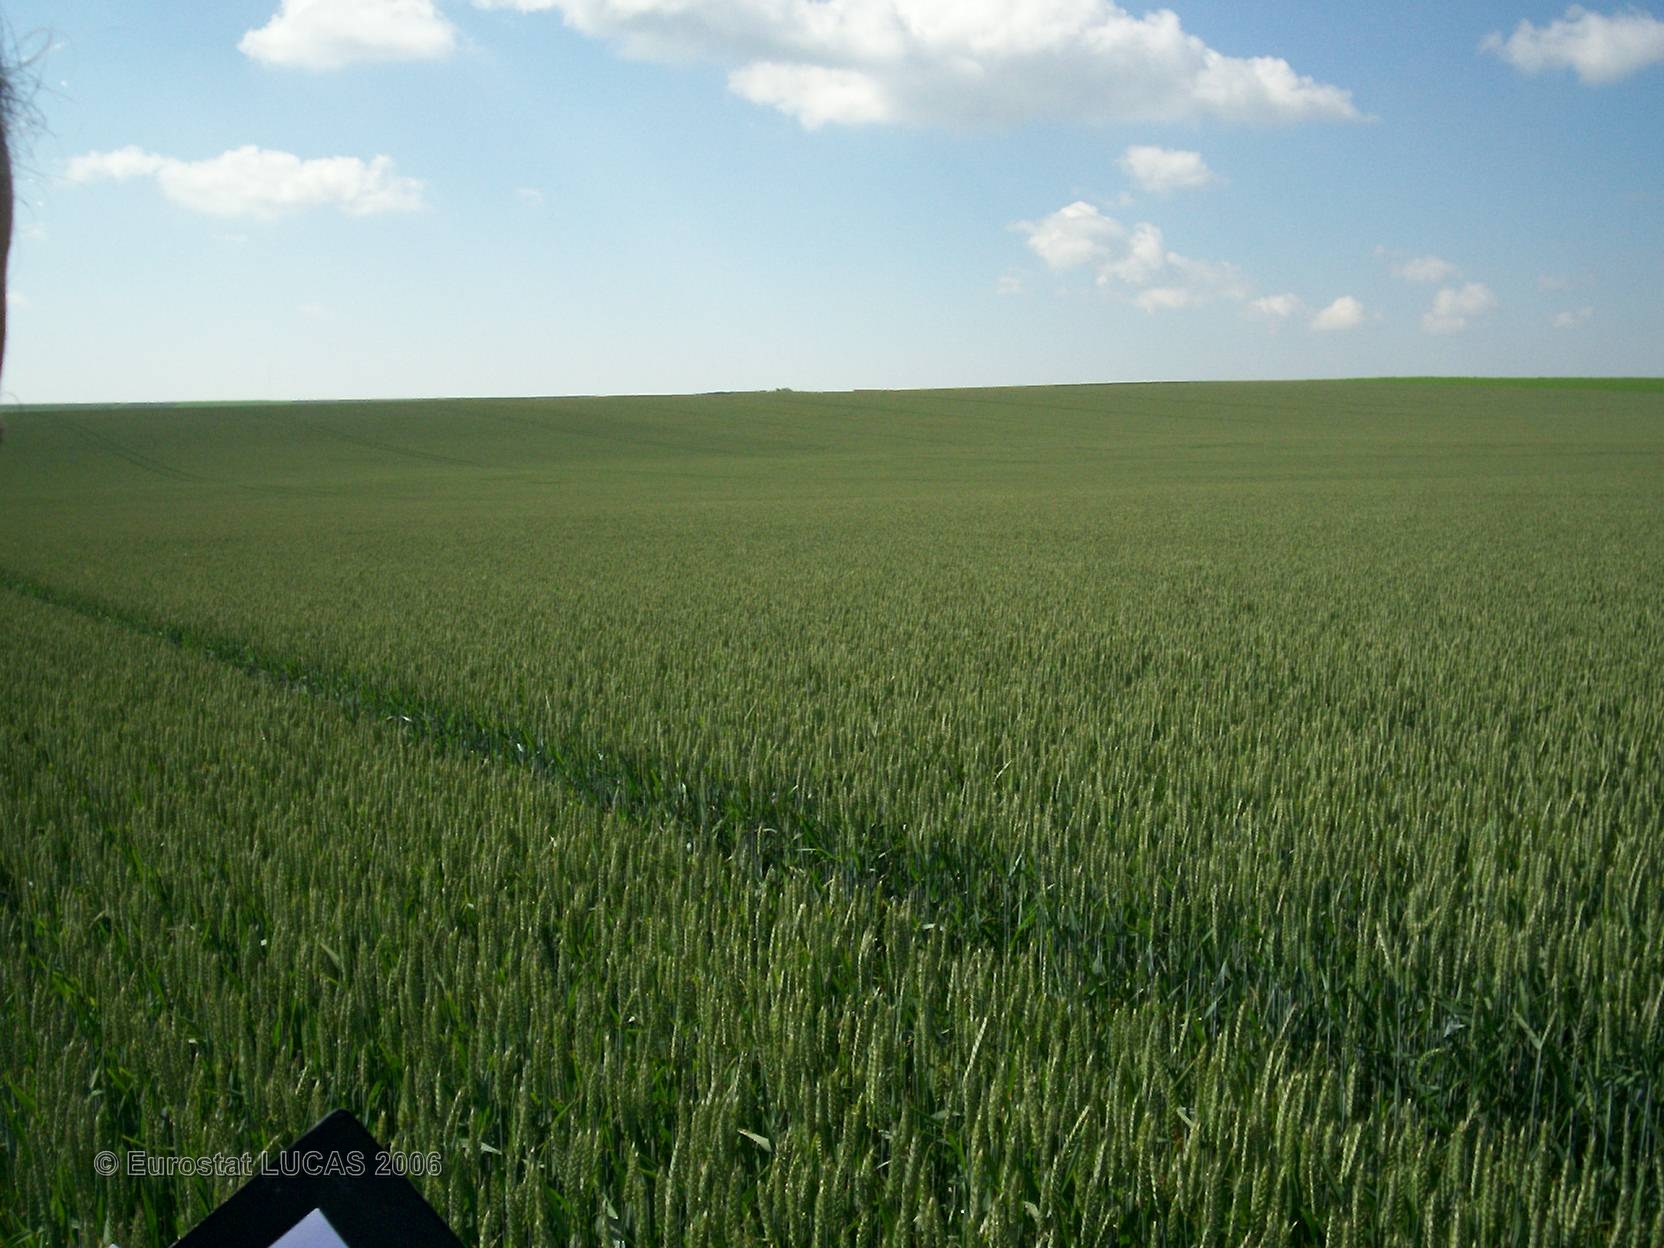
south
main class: Cropland
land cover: Common wheat
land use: Agriculture (excluding fallow land and kitchen gardens)
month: June
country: FR
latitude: 48.8206
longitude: 4.3988
